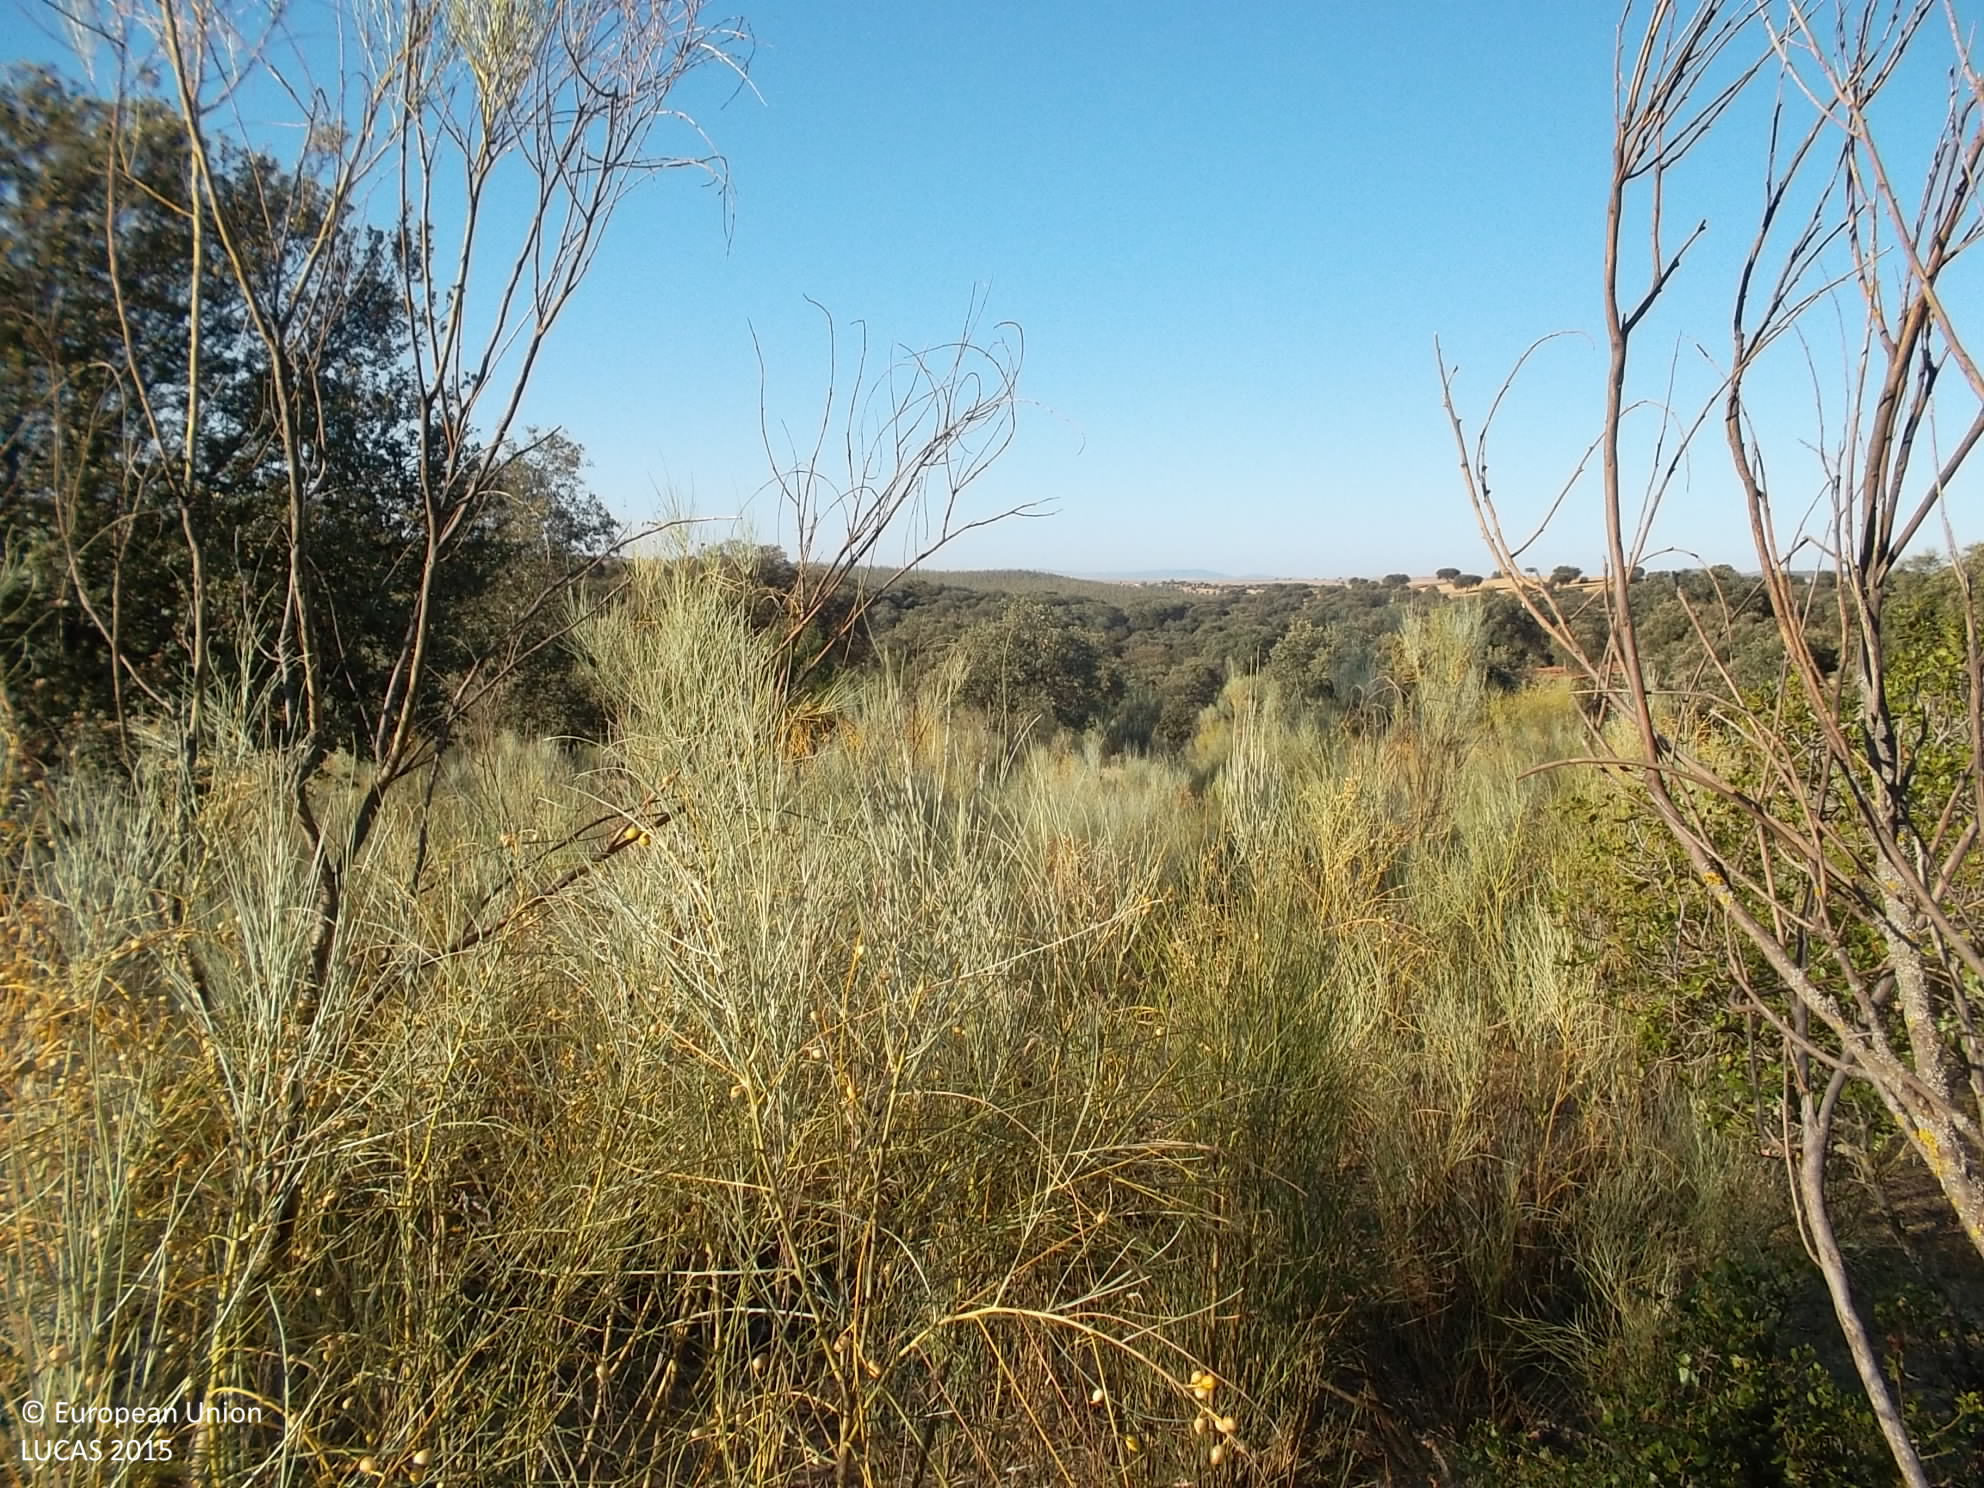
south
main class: Woodland
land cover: Broadleaved woodland
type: broadleaved evergreen forest
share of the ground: 10 - 25 %
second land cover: Spontaneously vegetated surfaces
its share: 10 - 25 %
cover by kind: unconsolidated bare surface 85 %, broadleaved forest trees 15 %
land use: Forestry
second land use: Fallow land
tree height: > 5 m
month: July
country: ES
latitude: 38.5058
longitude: -5.7616
